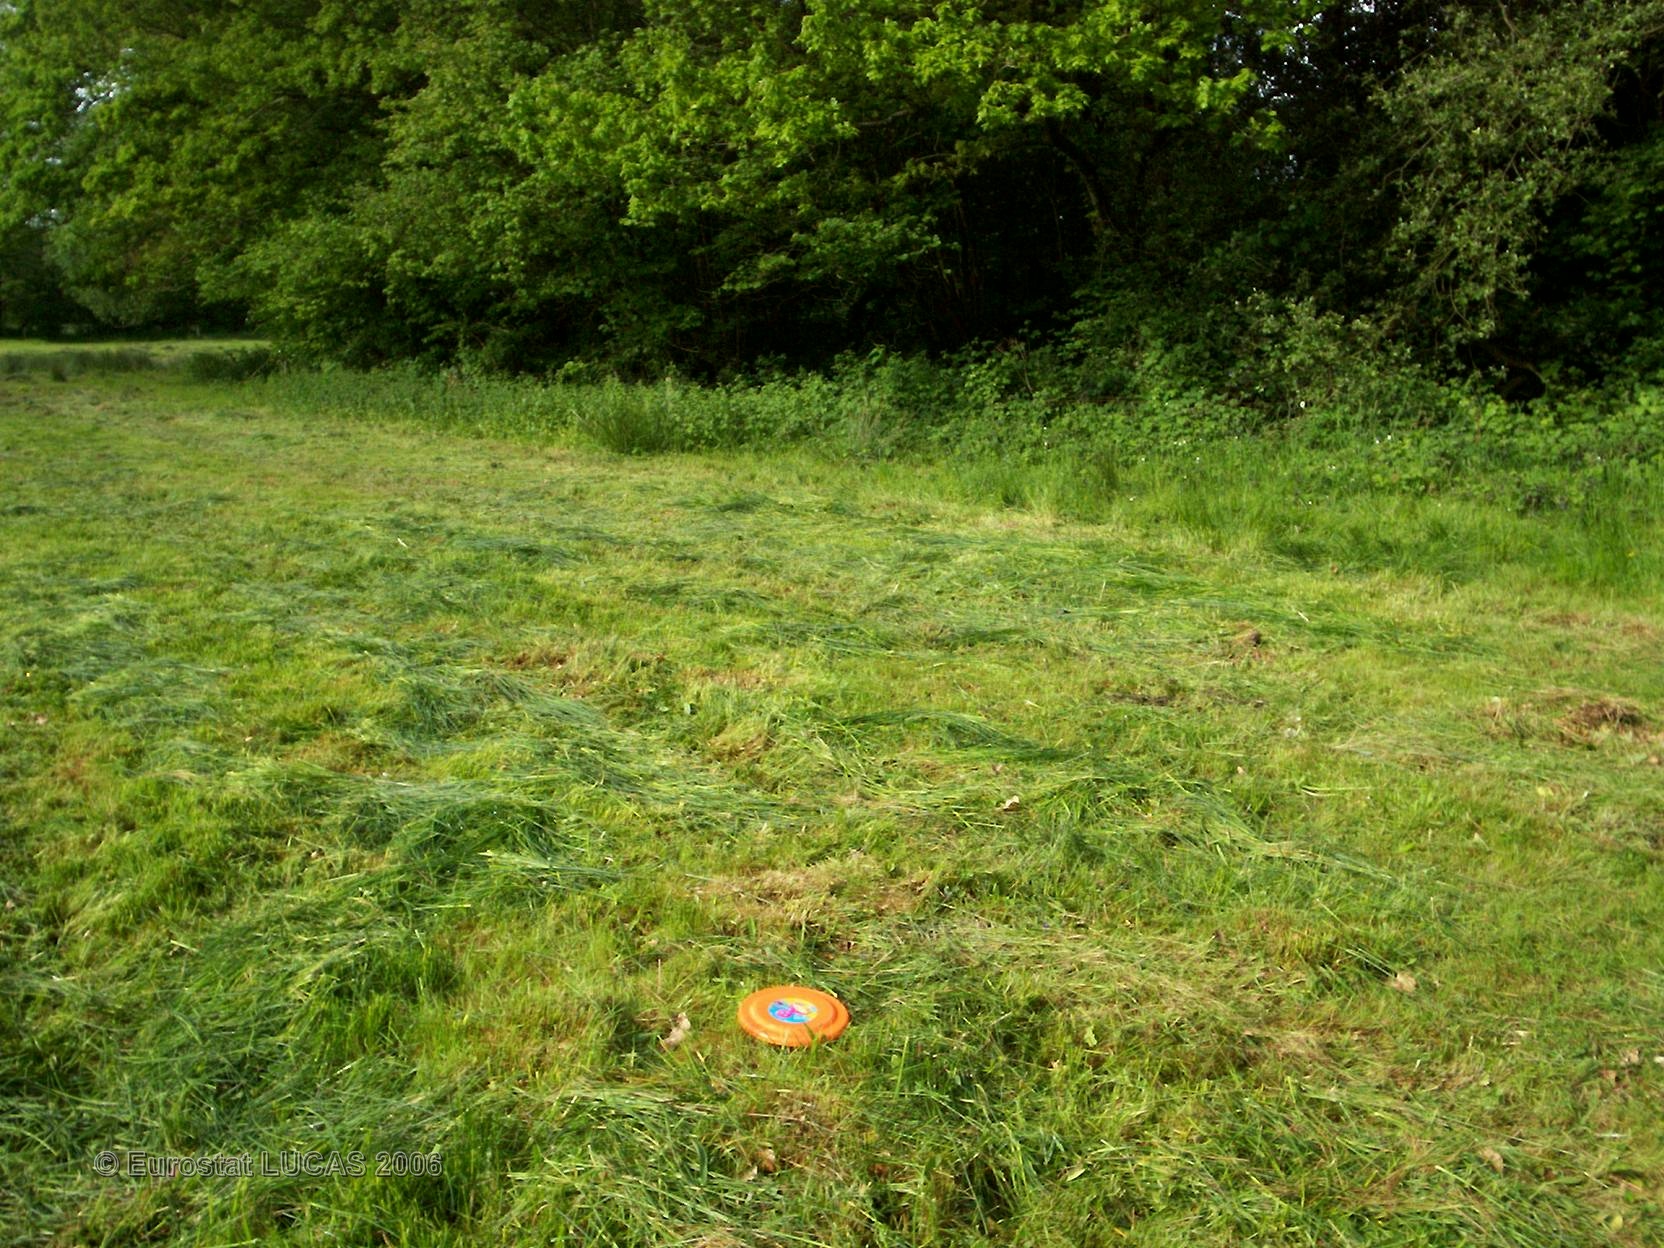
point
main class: Grassland
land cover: Grassland without tree/shrub cover
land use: Agriculture (excluding fallow land and kitchen gardens)
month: May
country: FR
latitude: 48.2888
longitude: -2.9942
